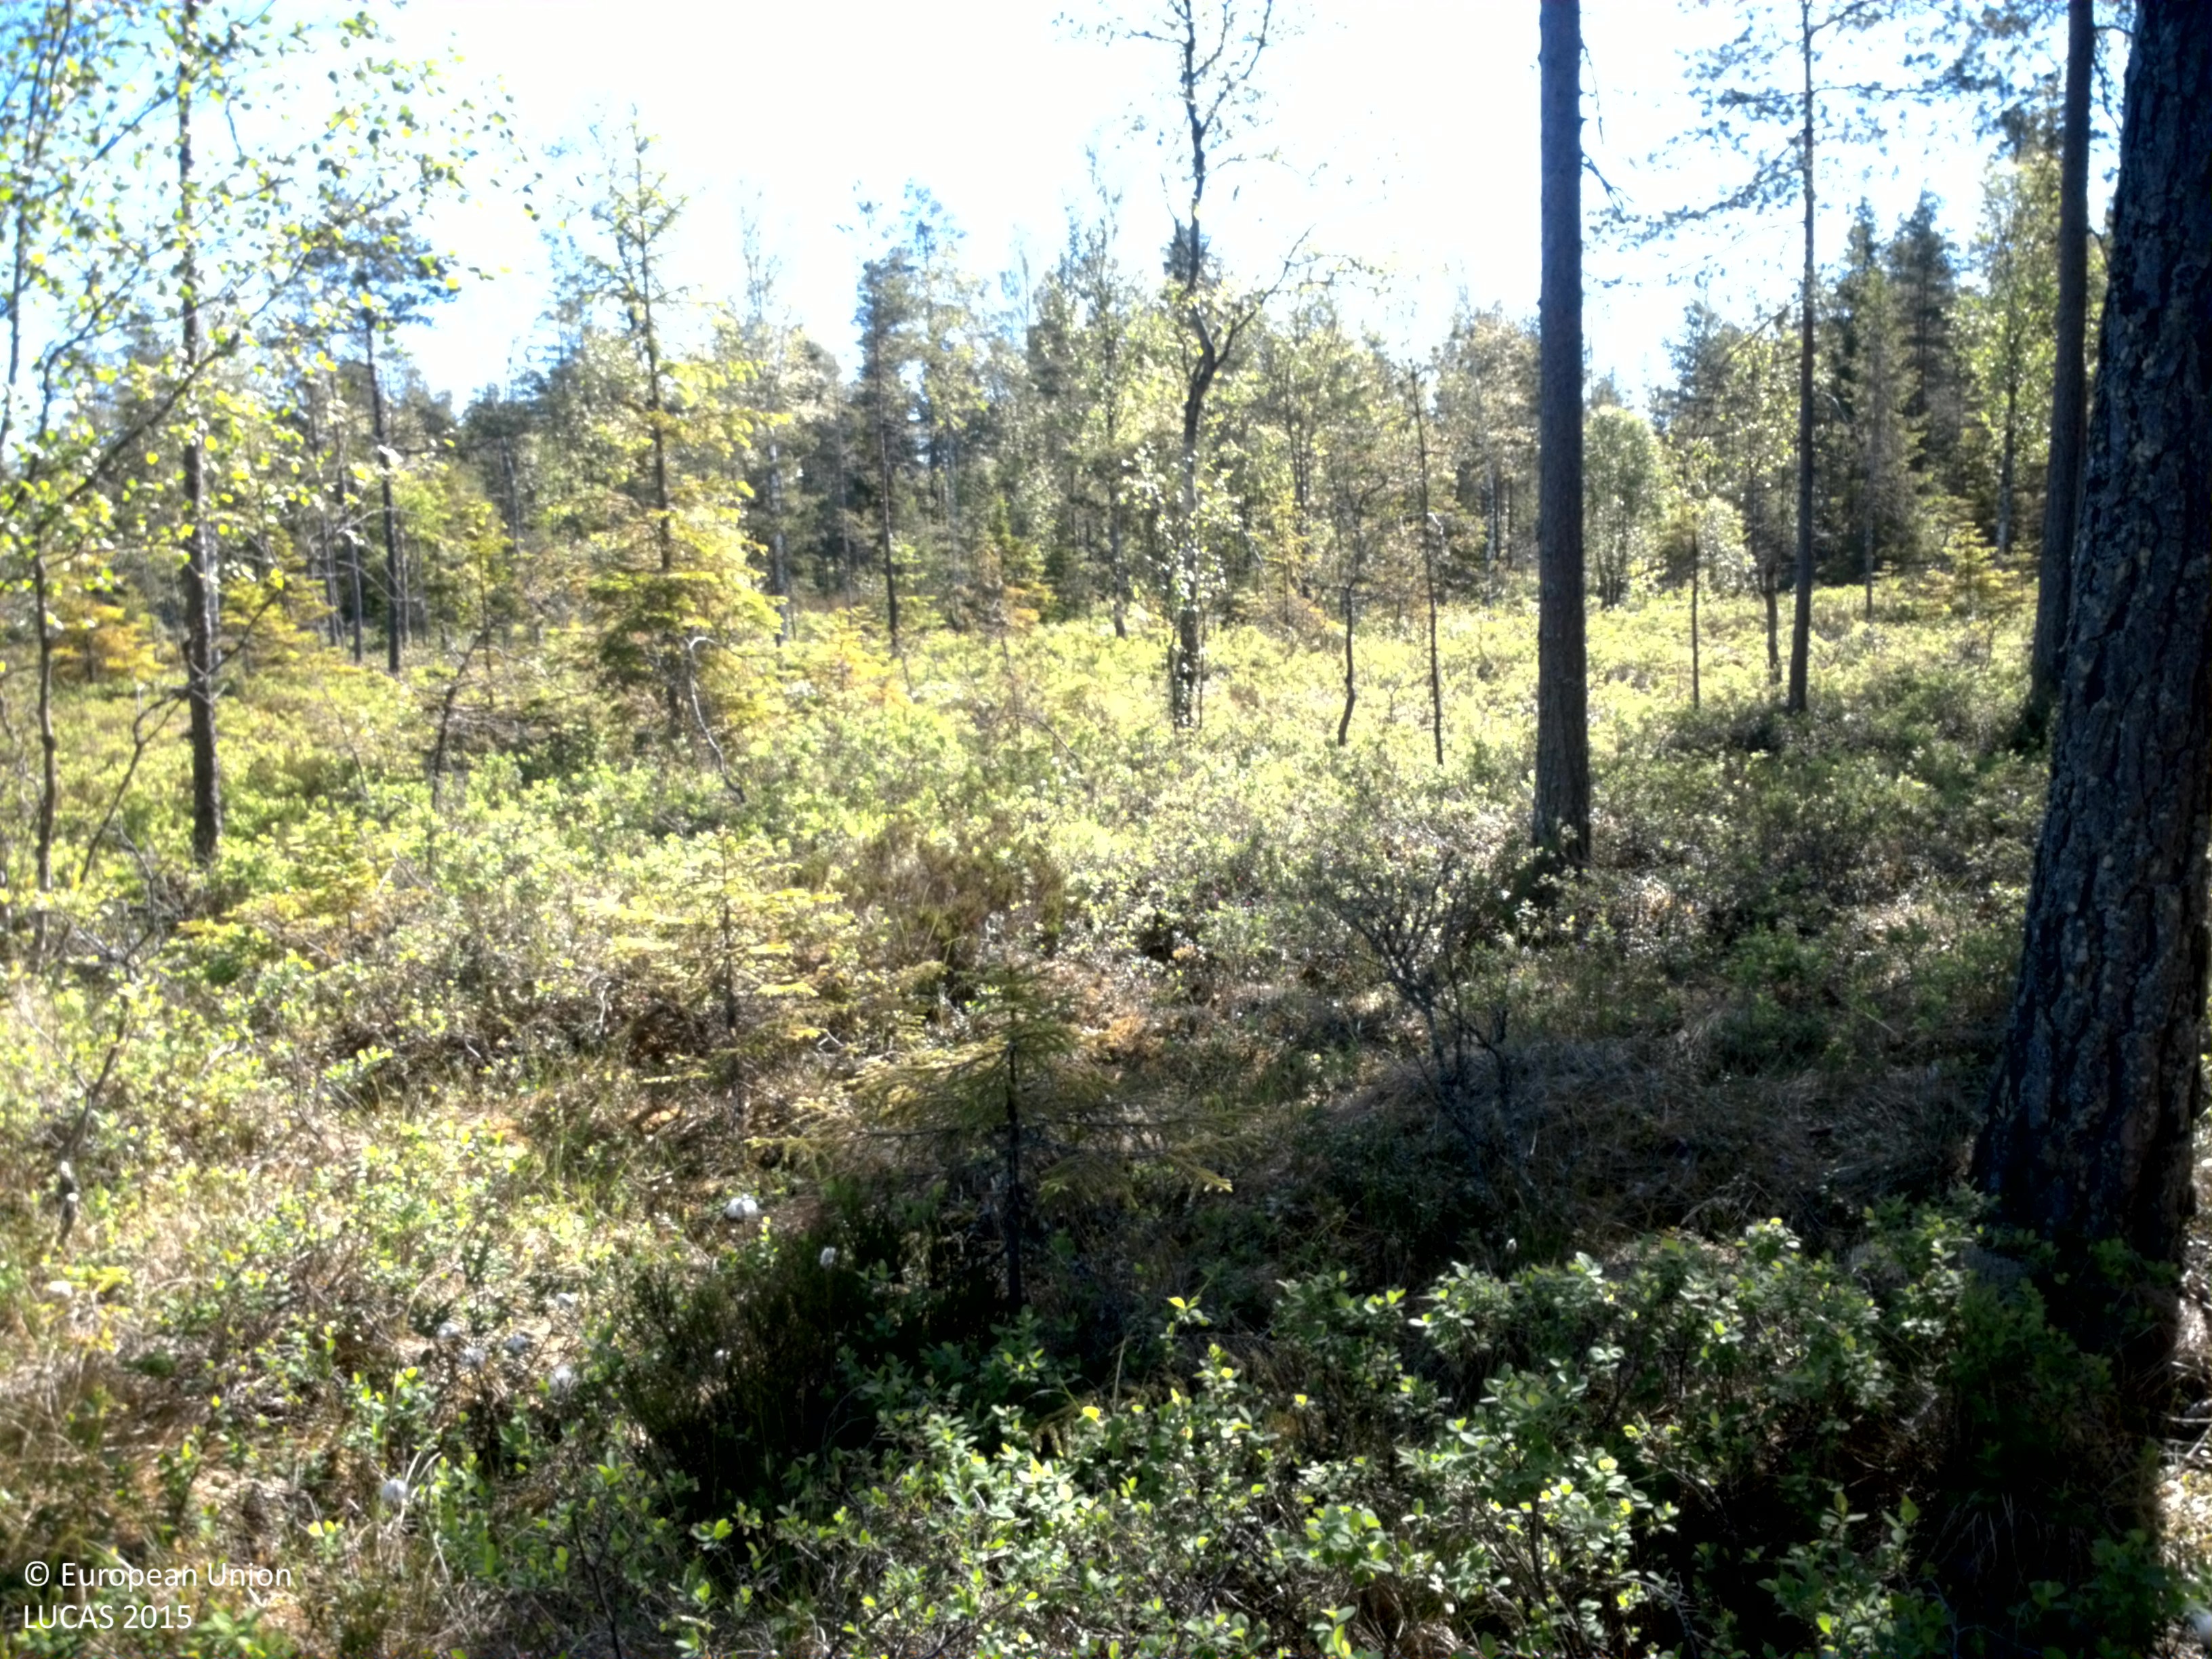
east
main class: Woodland
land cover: Pine dominated coniferous woodland
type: boreal forest
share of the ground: 50 - 75 %
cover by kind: coniferous forest trees 50 %, shrubs 25 %, herbaceous plants 10 %, lichens and mosses 10 %, broadleaved forest trees 5 %
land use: Forestry
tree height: > 5 m
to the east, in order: Pine dominated coniferous woodland; Shrubland with sparse tree cover; Pine dominated coniferous woodland; Pine dominated mixed woodland; Shrubland with sparse tree cover; Pine dominated coniferous woodland
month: June
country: SE
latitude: 59.4994
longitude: 12.0613
